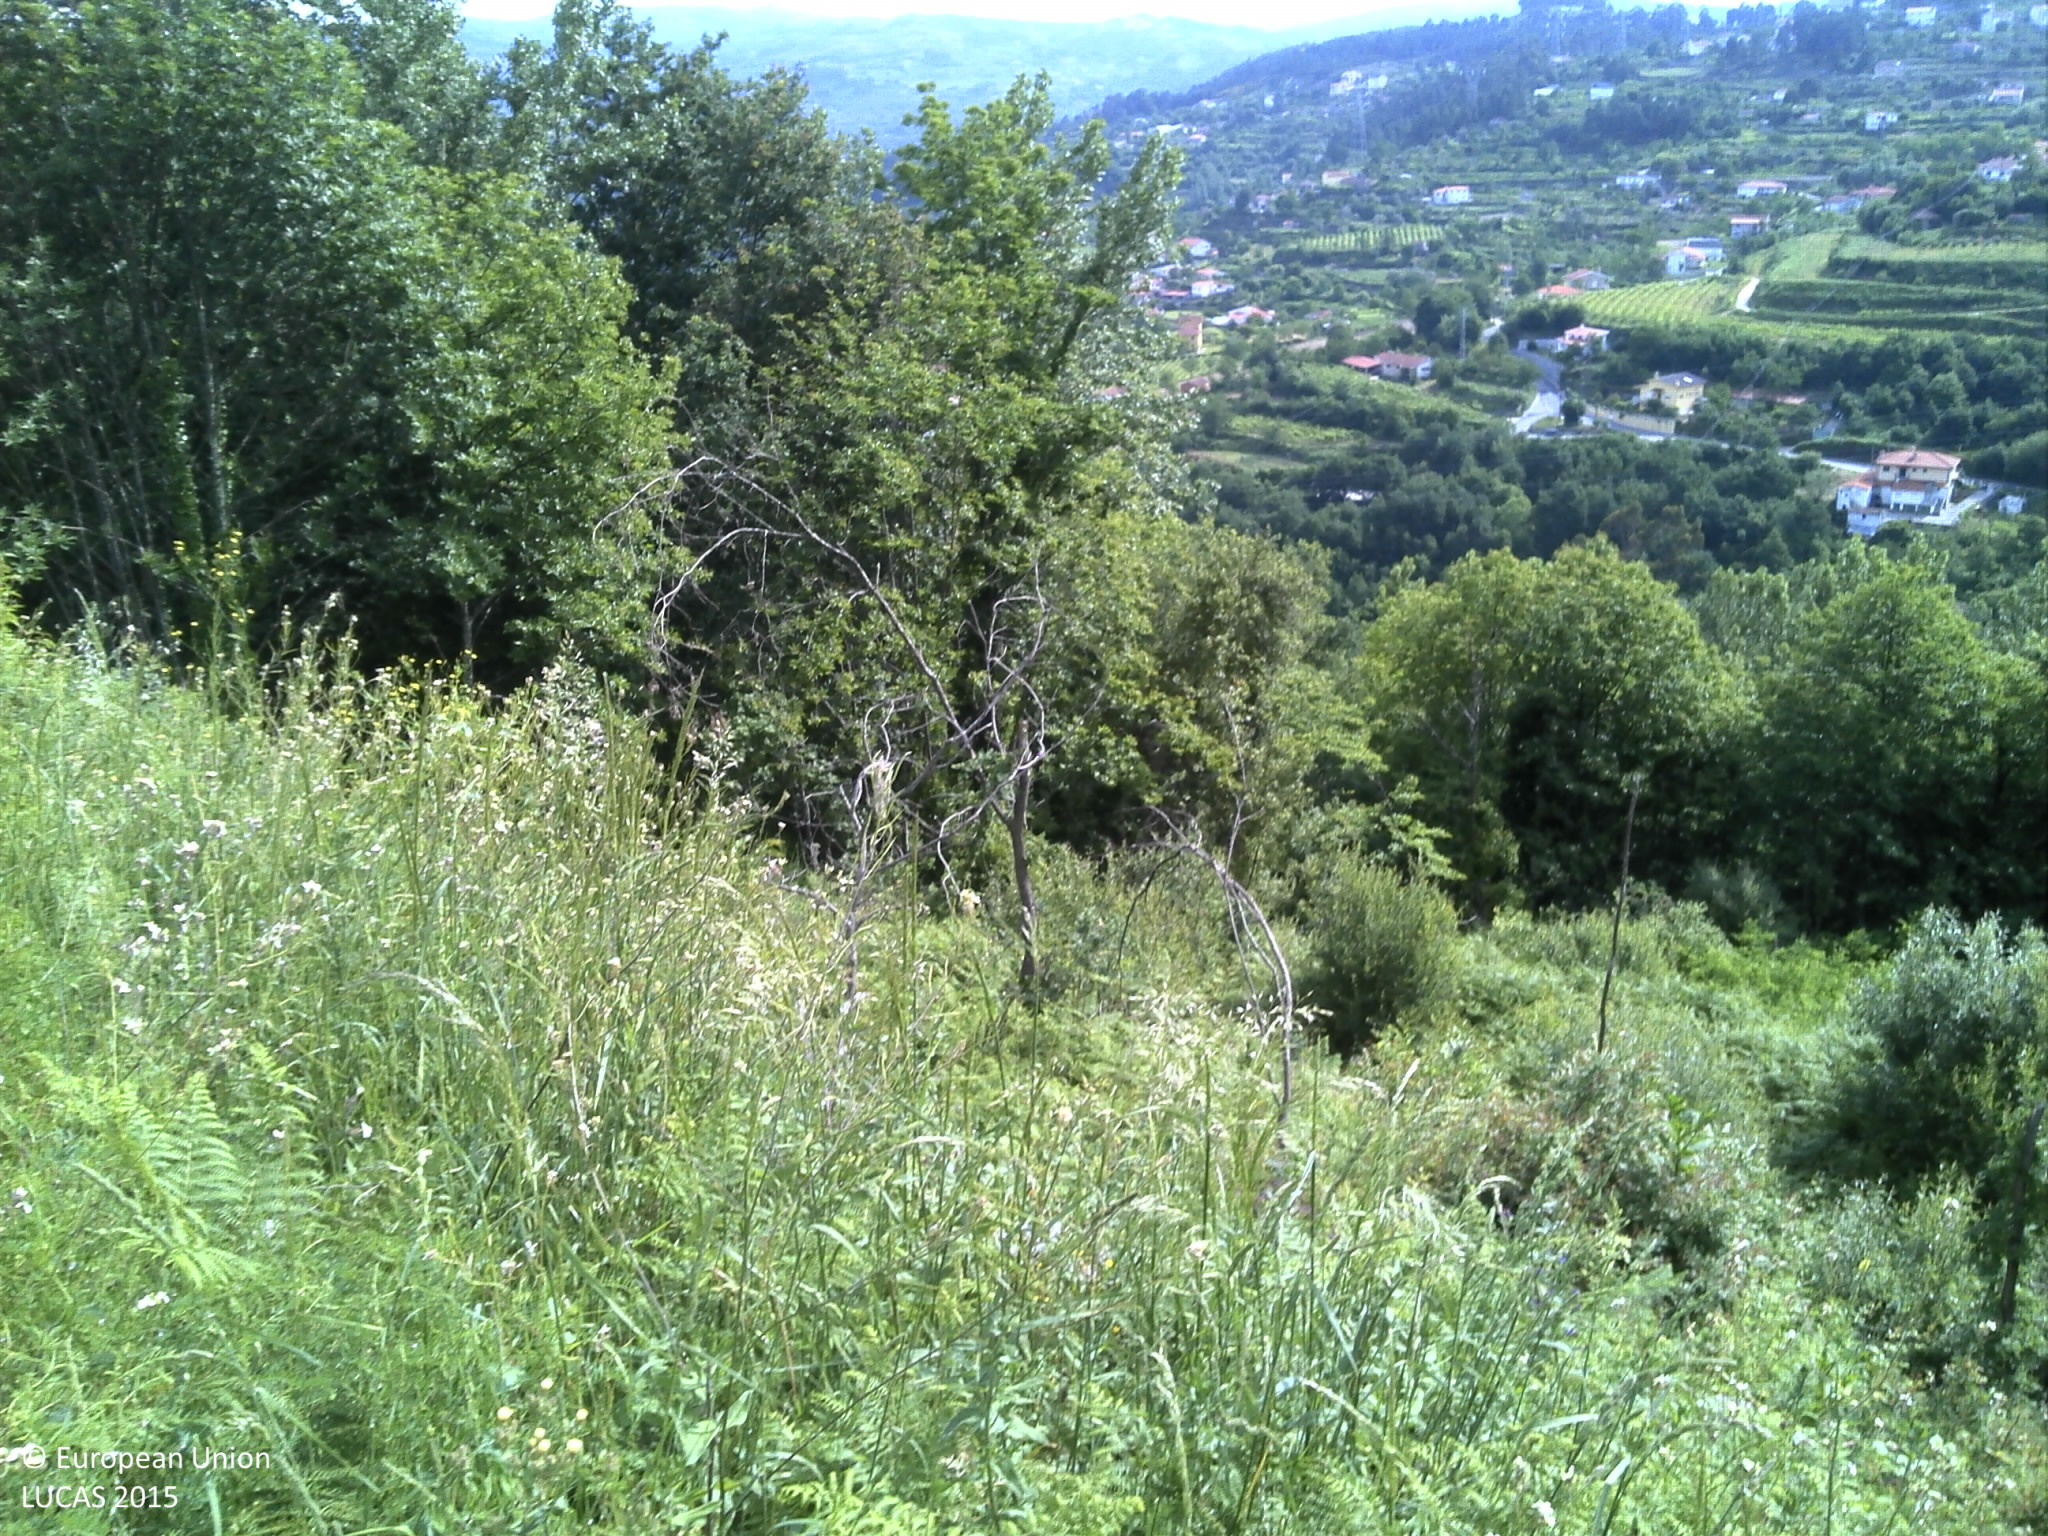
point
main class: Woodland
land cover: Broadleaved woodland
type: thermophilous deciduous forest
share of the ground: > 75 %
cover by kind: broadleaved forest trees 85 %, shrubs 5 %, herbaceous plants 5 %, unconsolidated bare surface 5 %
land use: Forestry
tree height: > 5 m
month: May
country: PT
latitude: 41.0770
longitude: -8.1217
